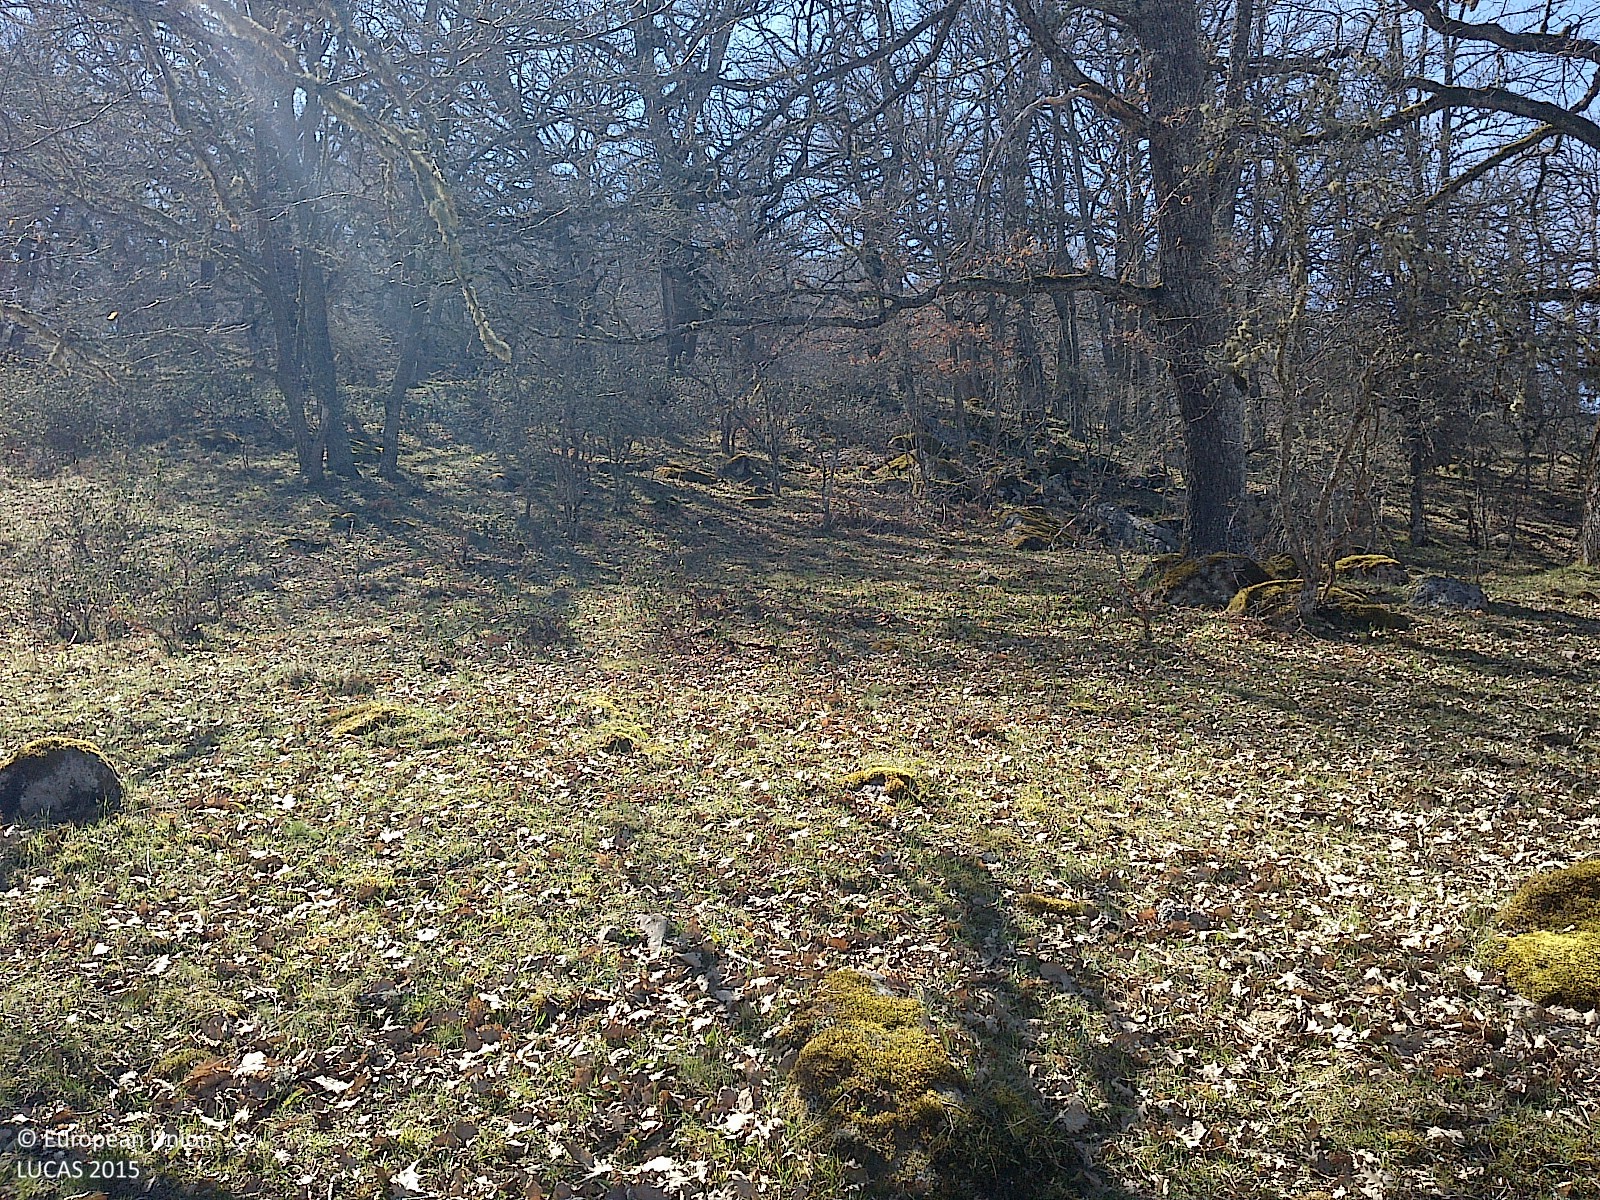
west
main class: Woodland
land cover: Broadleaved woodland
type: thermophilous deciduous forest
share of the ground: 10 - 25 %
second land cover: Spontaneously vegetated surfaces
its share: > 75 %
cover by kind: herbaceous plants 65 %, broadleaved forest trees 30 %, lichens and mosses 5 %
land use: Forestry
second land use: Agriculture (excluding fallow land and kitchen gardens)
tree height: > 5 m
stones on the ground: < 10 %
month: April
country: ES
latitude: 41.9407
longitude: -3.1349
